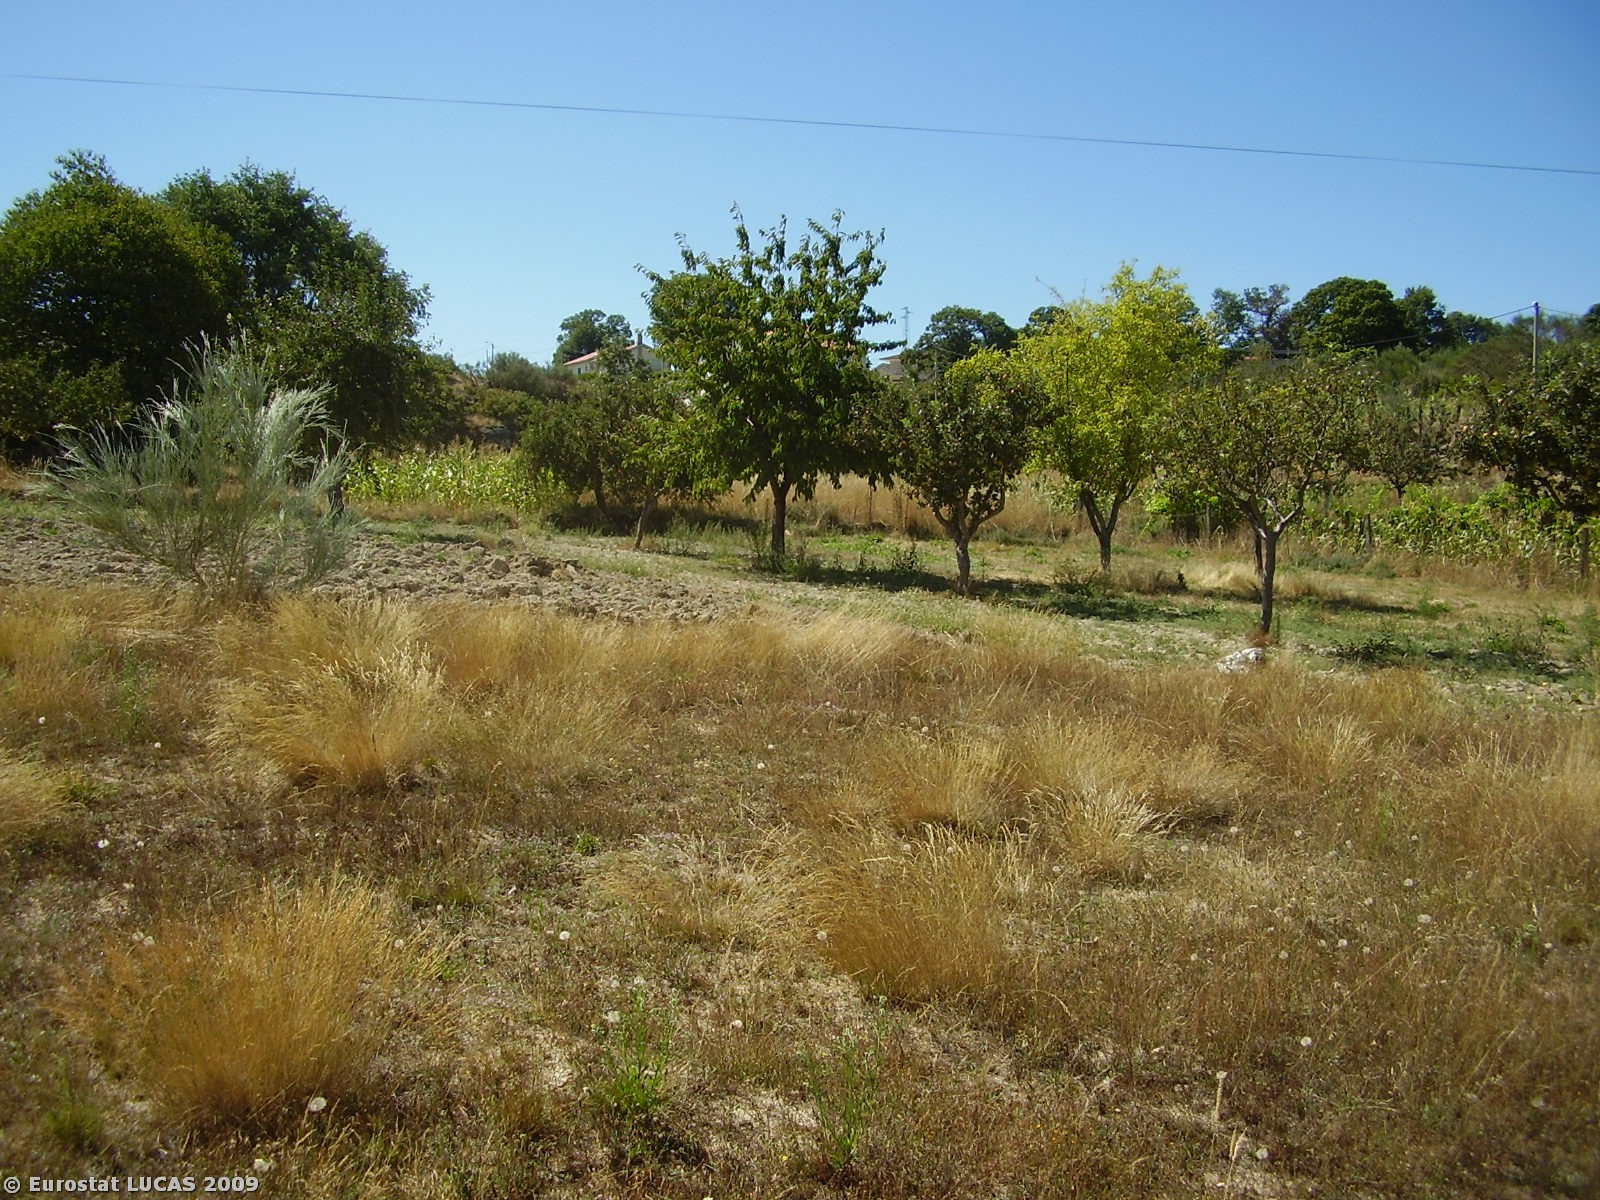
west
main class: Grassland
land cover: Spontaneously vegetated surfaces
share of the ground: > 75 %
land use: Fallow land
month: September
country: PT
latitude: 41.8481
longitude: -7.6364
